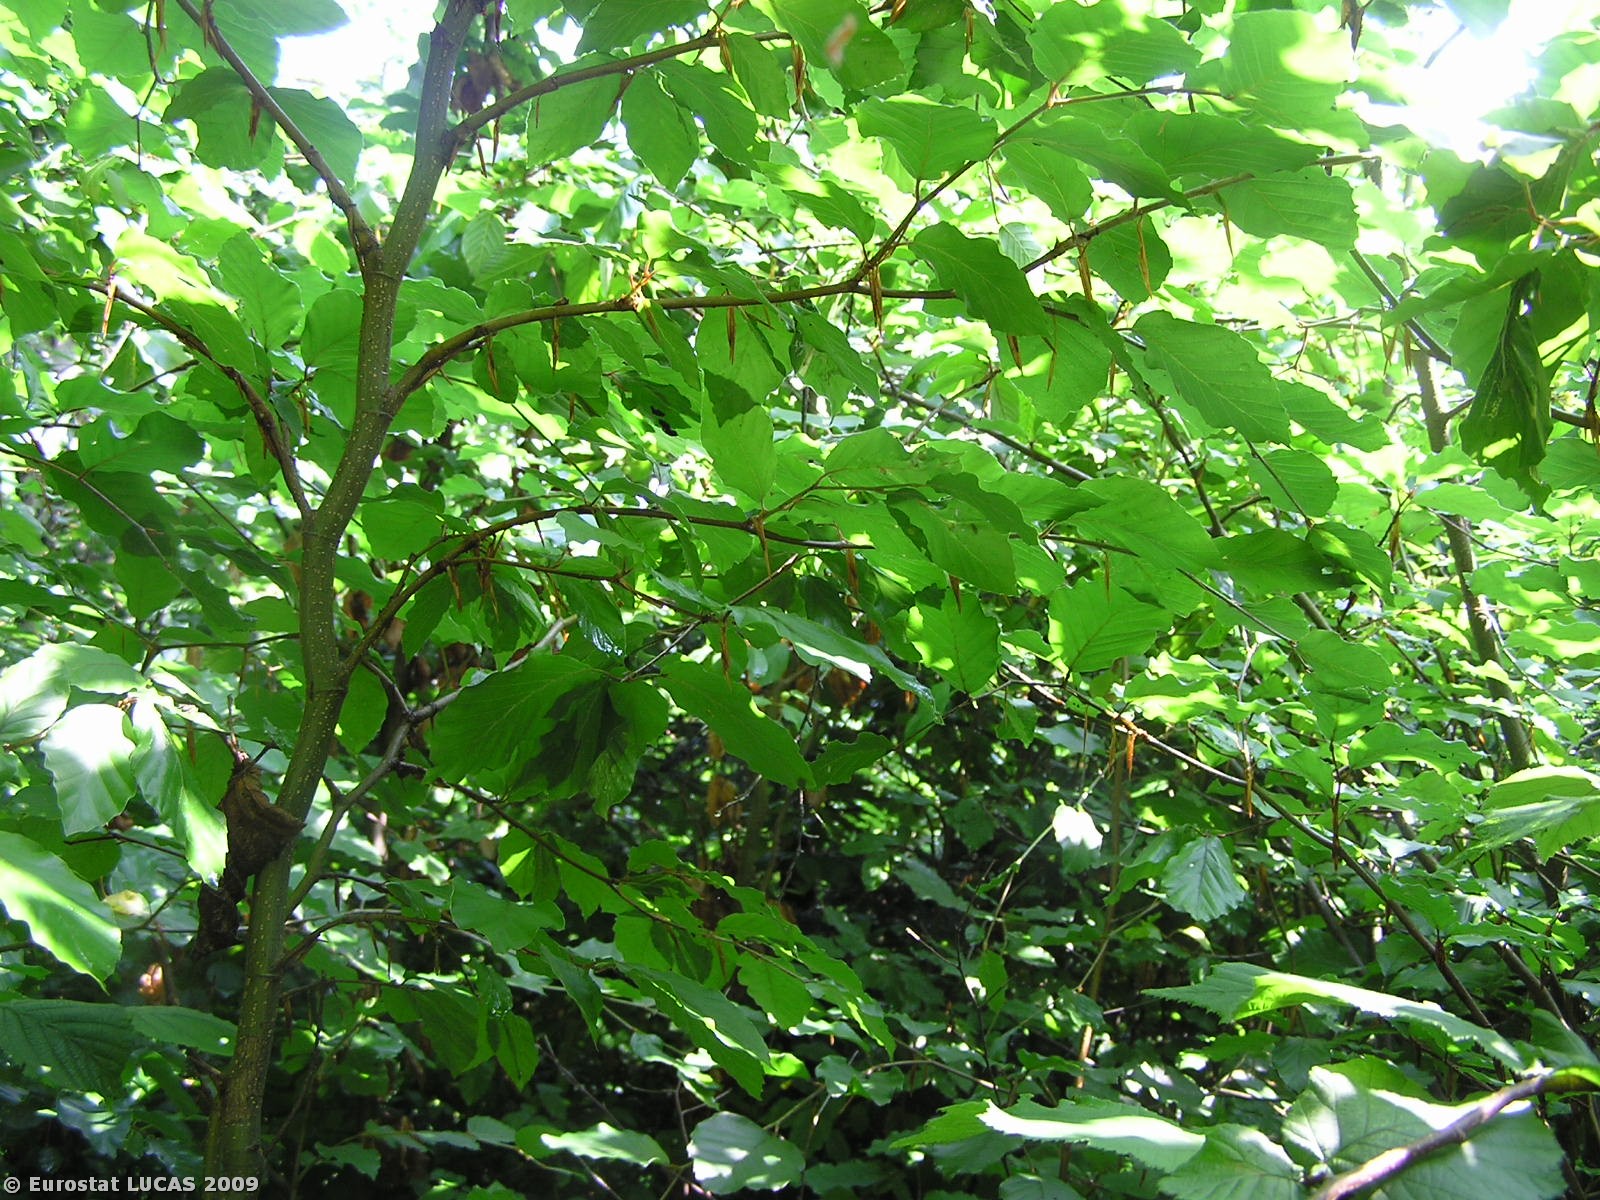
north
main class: Woodland
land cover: Mixed woodland
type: hemiboreal forest and nemoral coniferous forest and mixed broadleaved-coniferous forest
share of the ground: > 75 %
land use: Forestry
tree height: > 5 m
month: June
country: CZ
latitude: 50.2647
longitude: 17.4615
